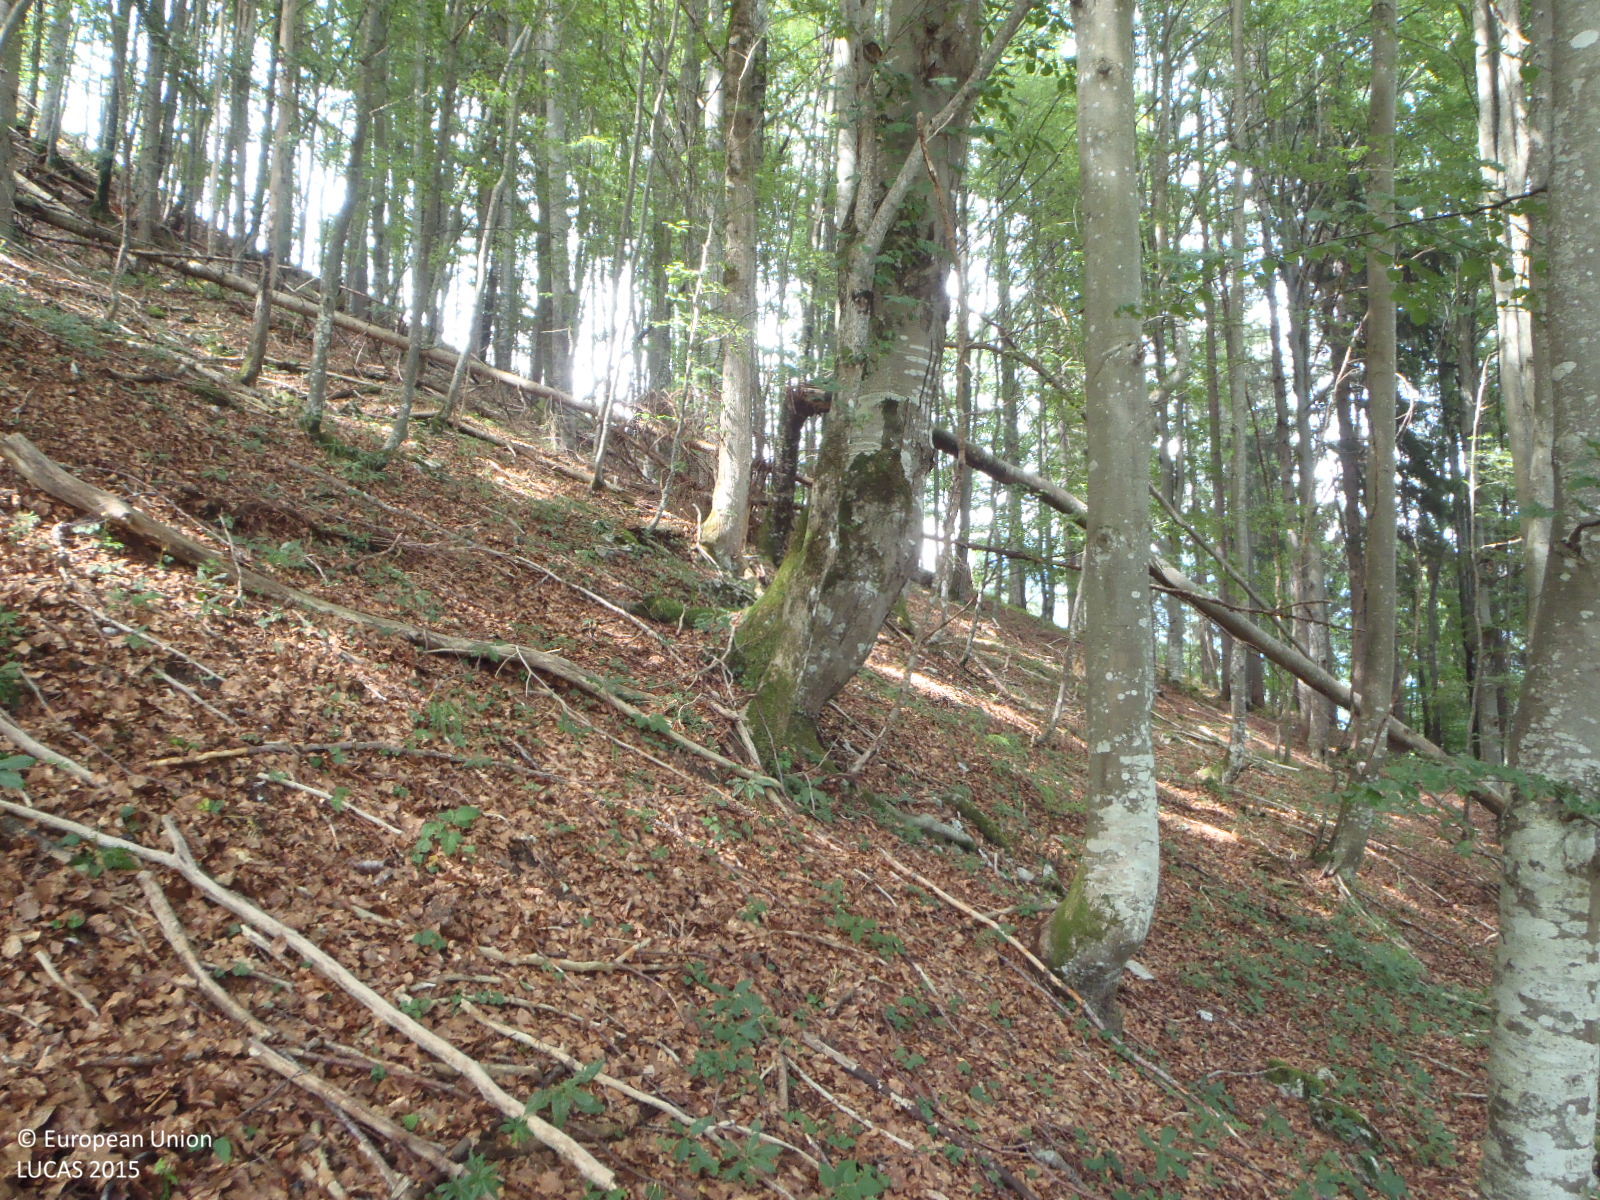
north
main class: Woodland
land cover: Broadleaved woodland
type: mountainous beech forest
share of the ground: > 75 %
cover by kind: broadleaved forest trees 85 %, coniferous forest trees 5 %, herbaceous plants 5 %, unconsolidated bare surface 5 %
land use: Forestry
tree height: > 5 m
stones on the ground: < 10 %
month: July
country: AT
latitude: 47.5747
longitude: 12.0325
